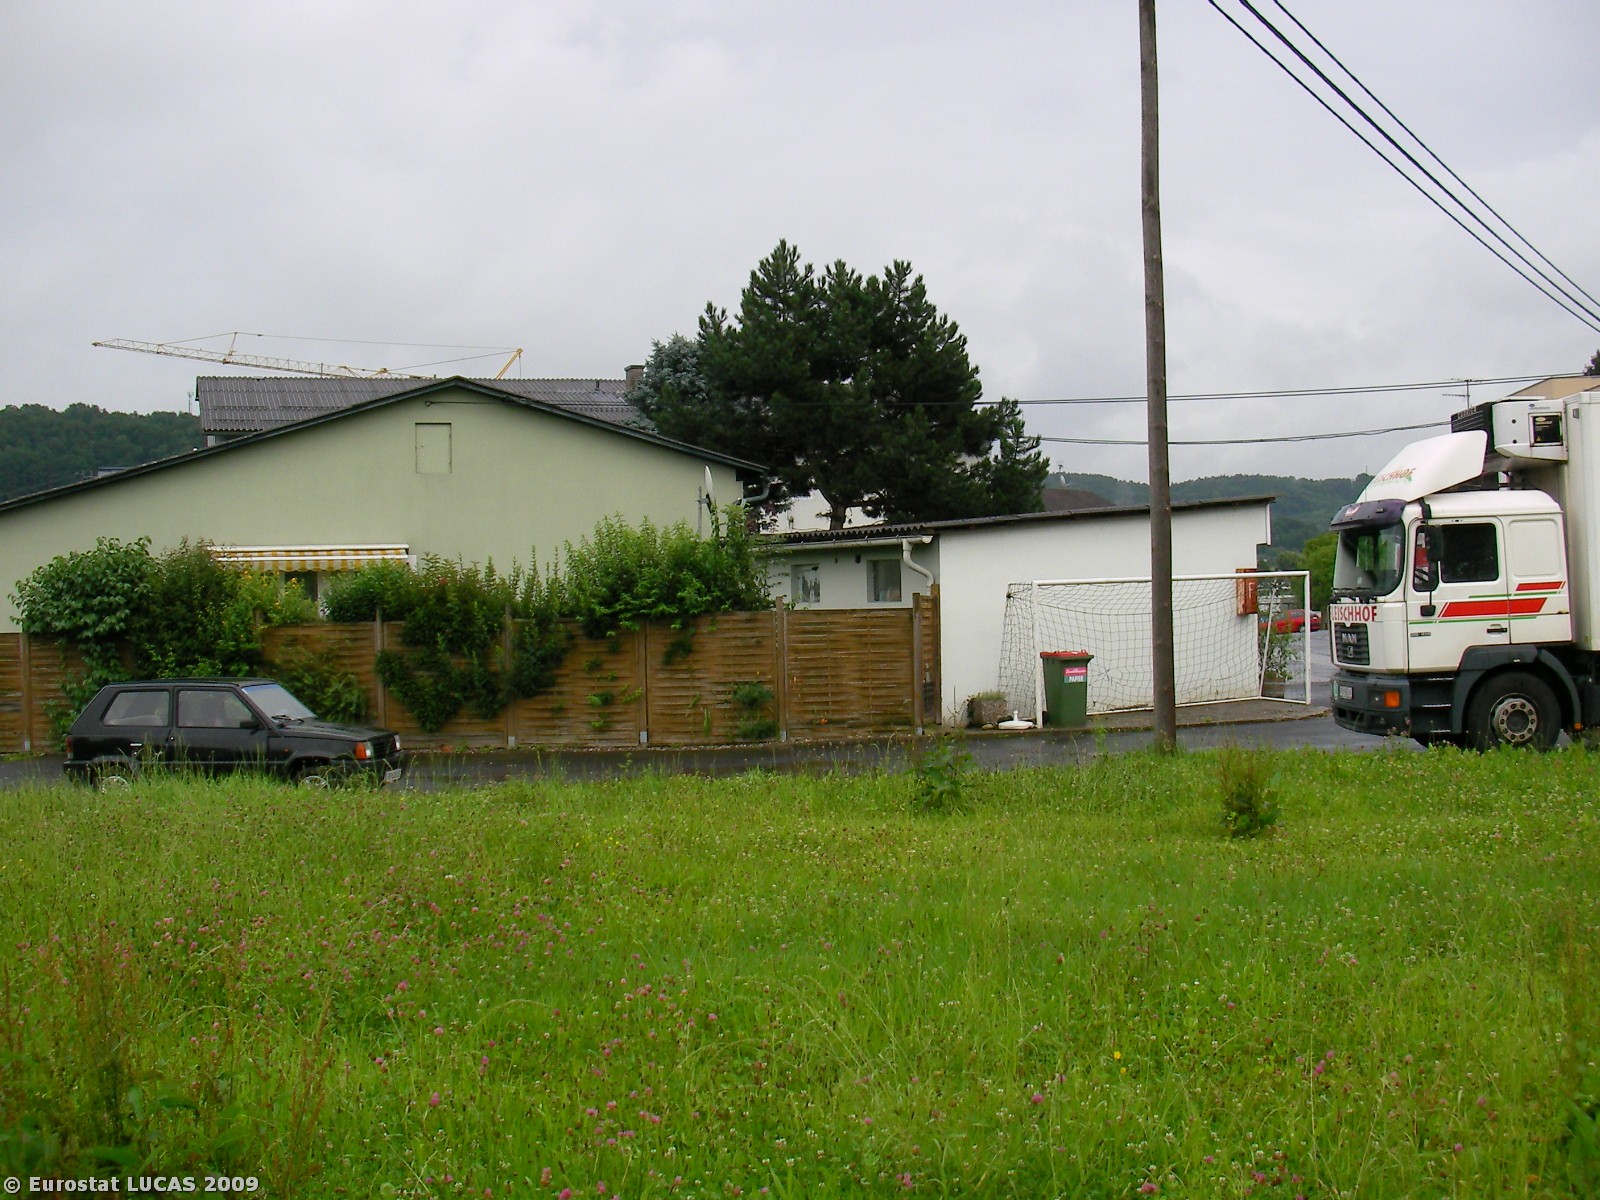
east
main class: Grassland
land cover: Grassland without tree/shrub cover
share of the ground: > 75 %
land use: Agriculture (excluding fallow land and kitchen gardens)
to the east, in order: Grassland without tree/shrub cover; Electric lines; Grassland without tree/shrub cover; Paved roads, cycling and walking lanes; Artificial constructions in urban areas; Fences; Spontaneously vegetated surfaces; Maize
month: July
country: AT
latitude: 46.9027
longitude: 15.7105
